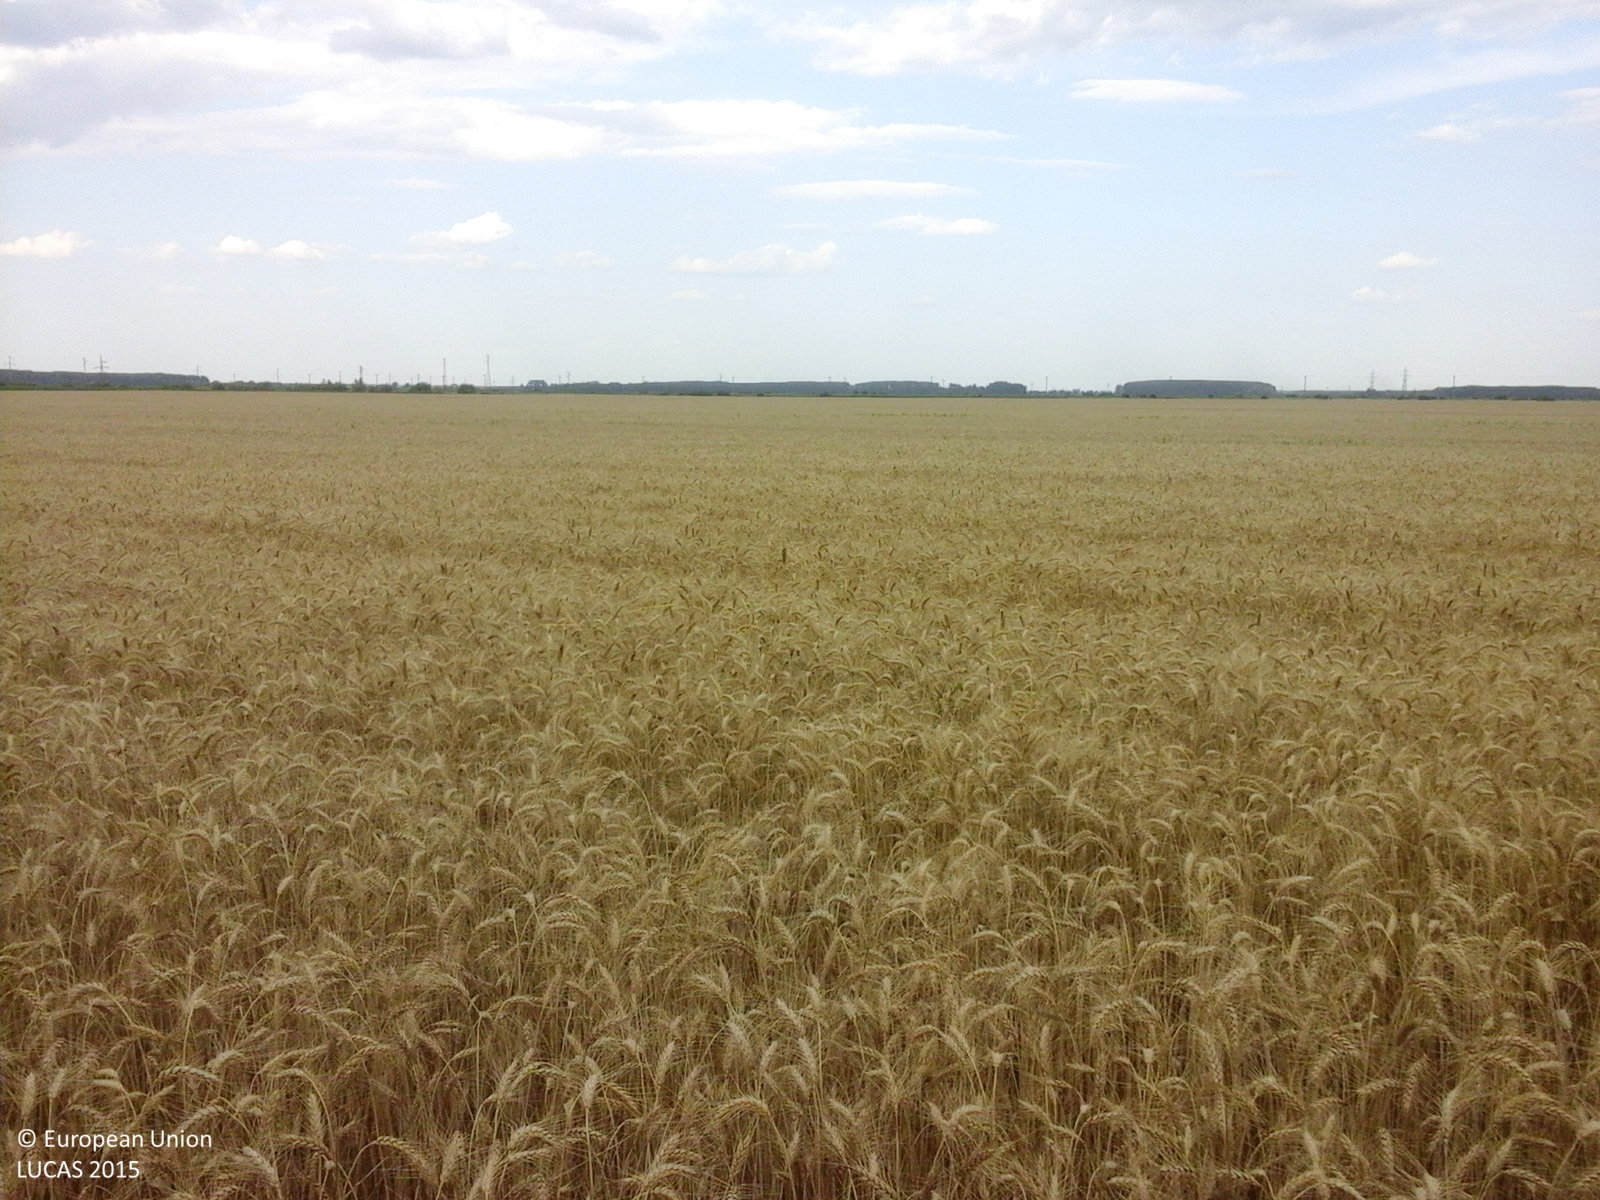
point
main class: Cropland
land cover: Common wheat
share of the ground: > 75 %
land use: Agriculture (excluding fallow land and kitchen gardens)
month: June
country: RO
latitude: 44.1240
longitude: 26.5976
